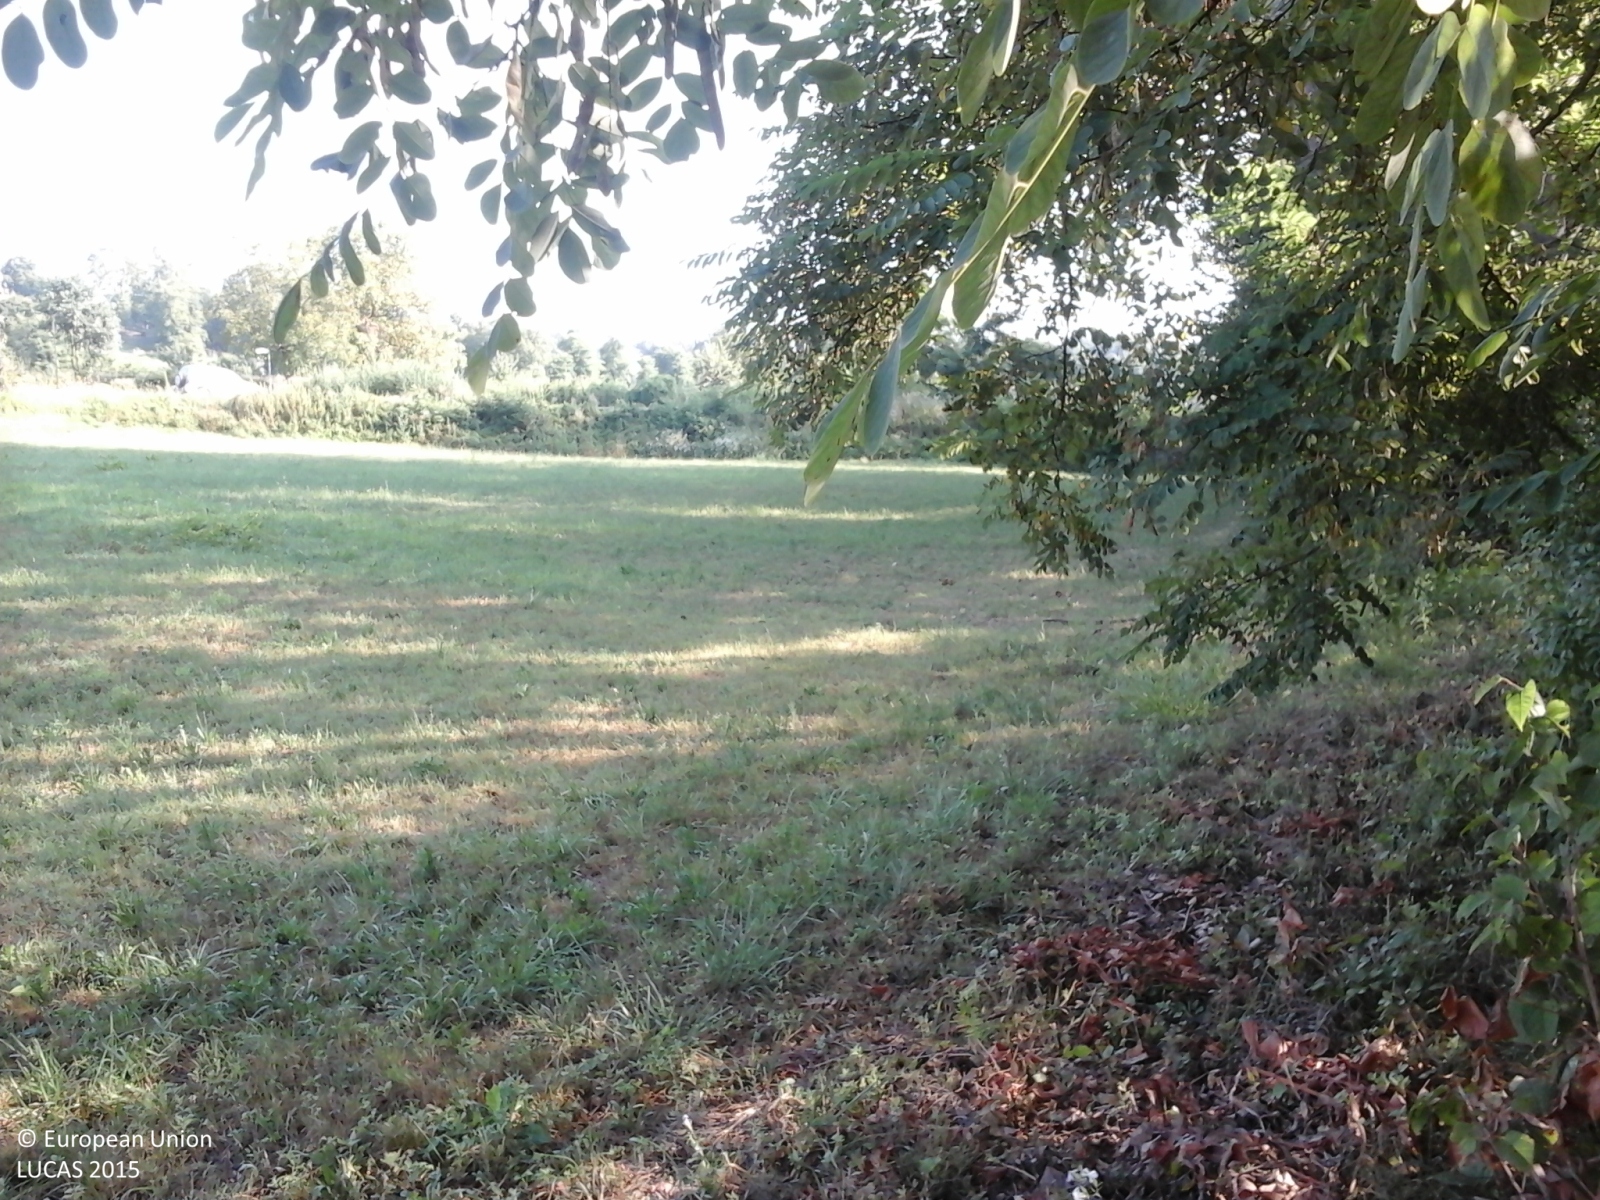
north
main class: Woodland
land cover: Broadleaved woodland
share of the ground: > 75 %
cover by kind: broadleaved forest trees 95 %, shrubs 5 %
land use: Semi-natural and natural areas not in use
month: August
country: IT
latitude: 44.4001
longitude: 7.8325
